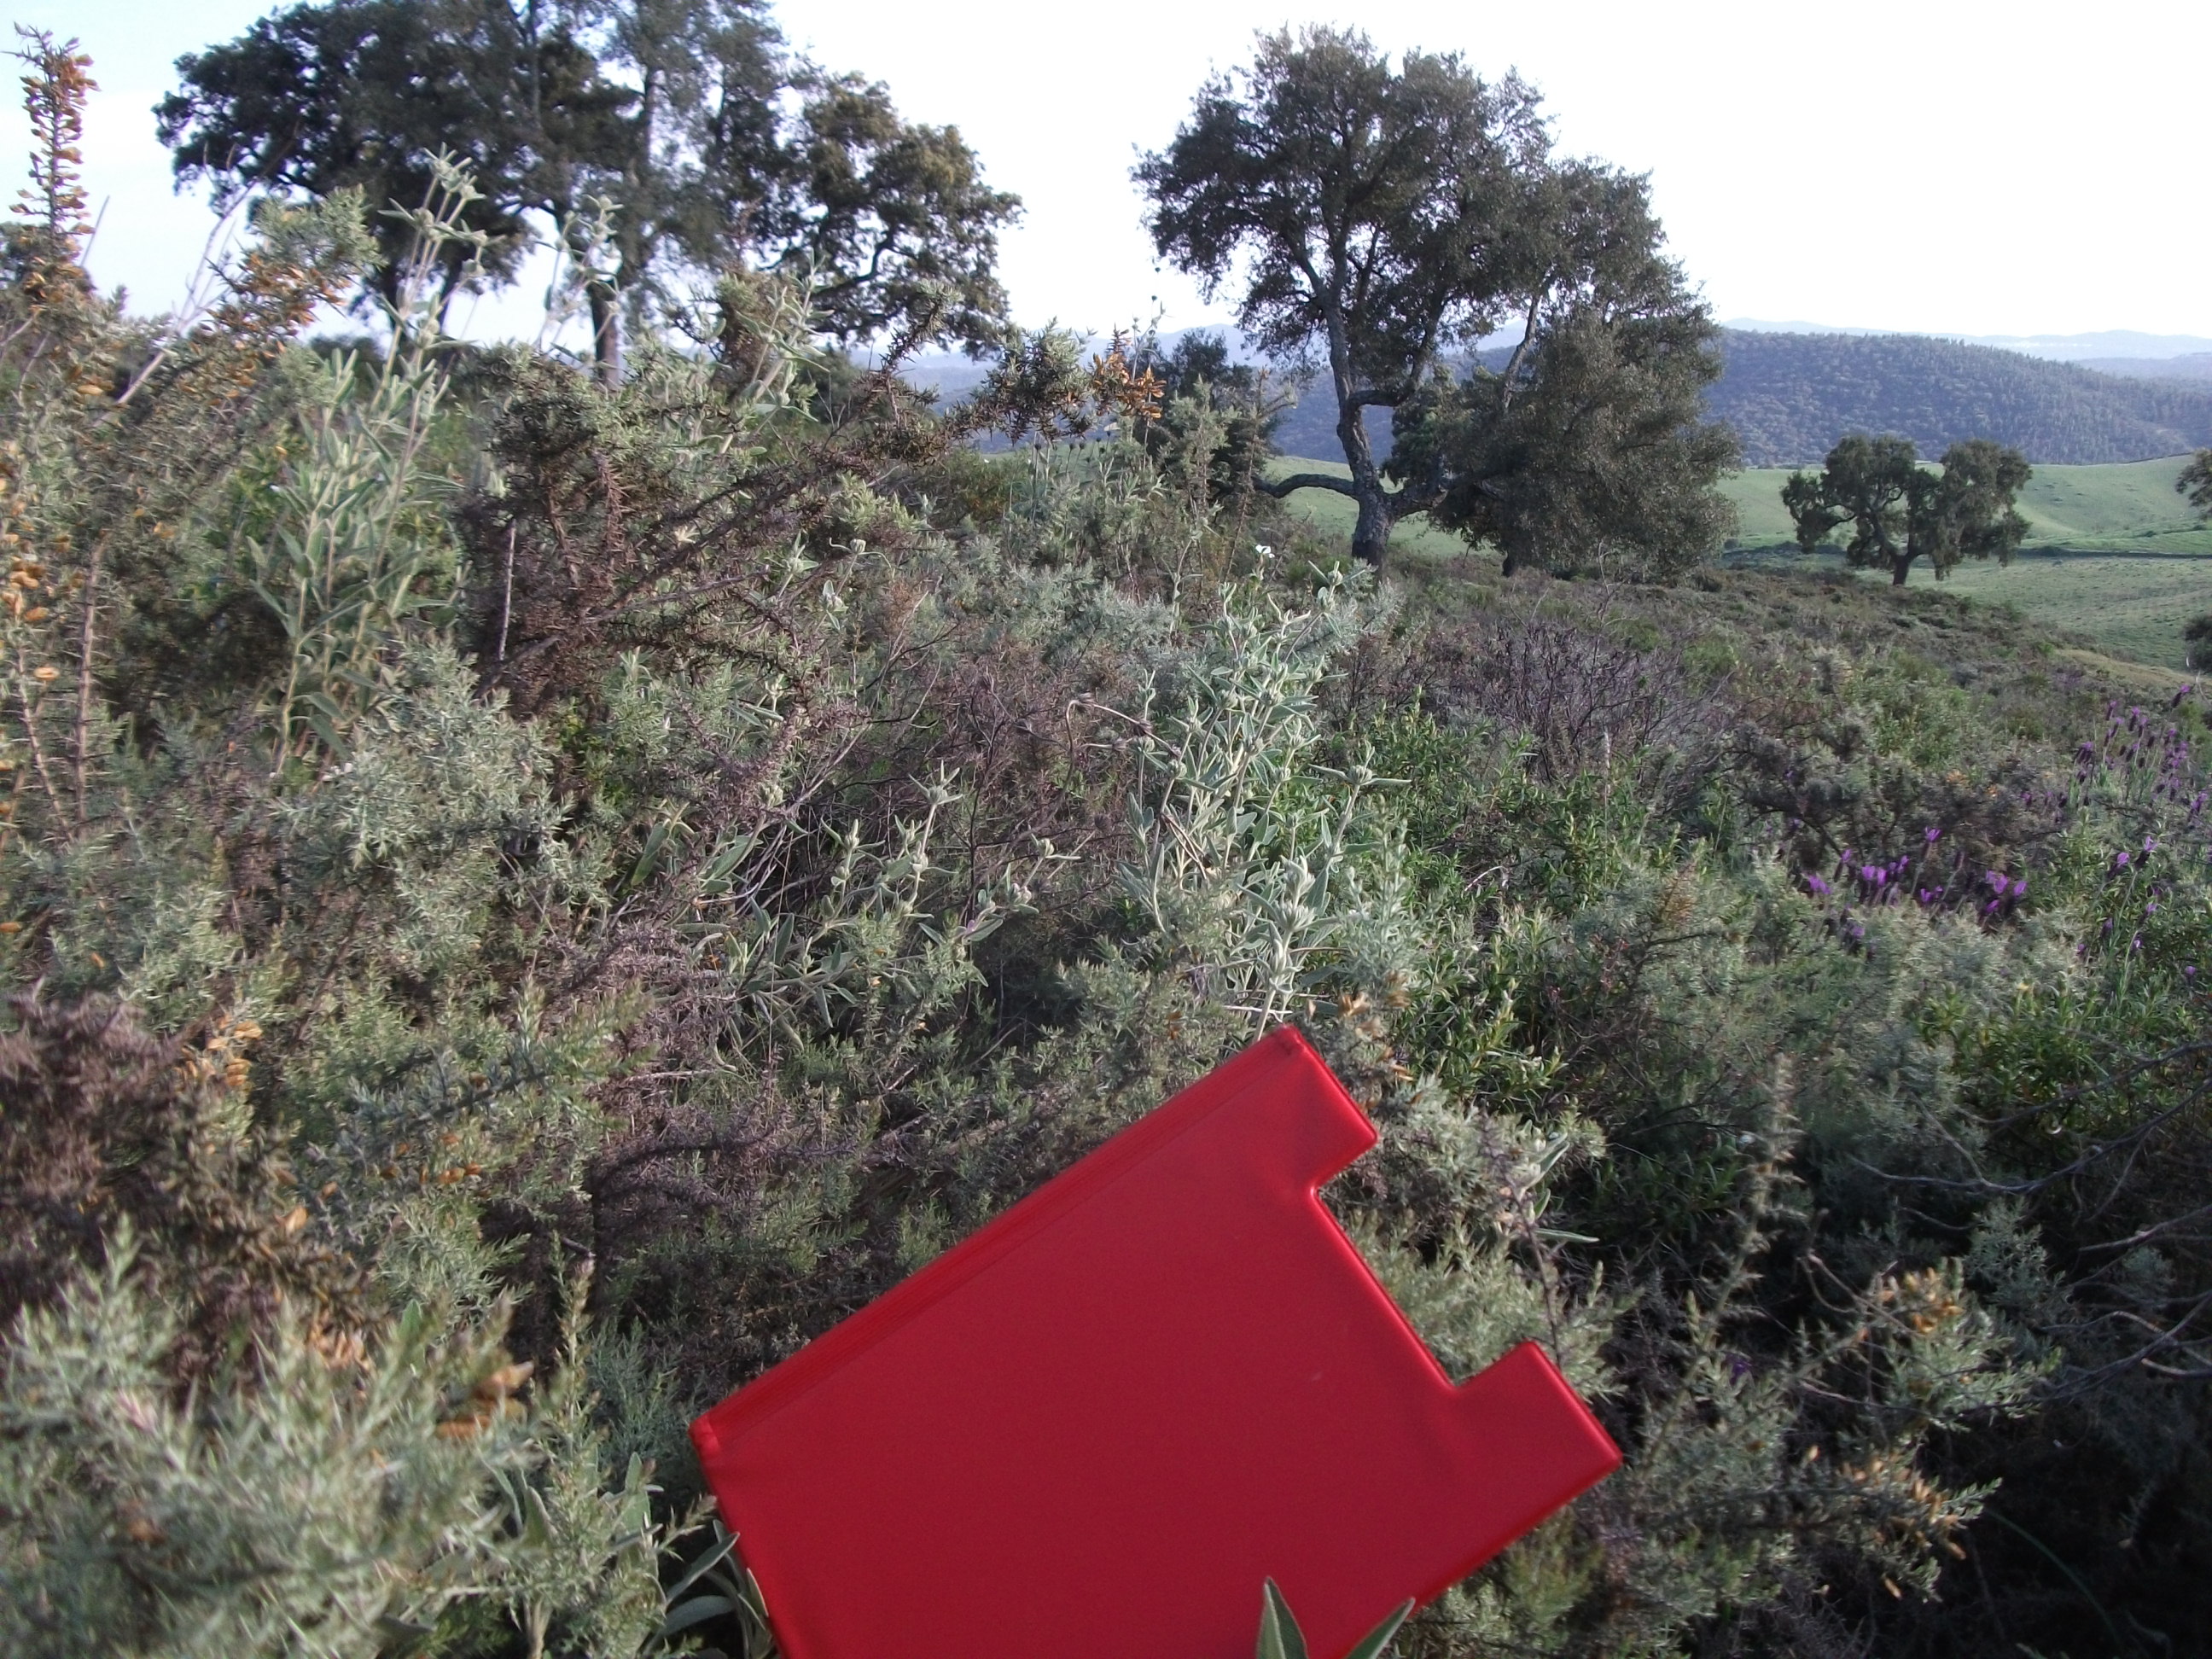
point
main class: Woodland
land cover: Broadleaved woodland
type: broadleaved evergreen forest
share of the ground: 10 - 25 %
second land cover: Shrubland without tree cover
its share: > 75 %
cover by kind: shrubs 90 %, broadleaved forest trees 10 %
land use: Forestry
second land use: Agriculture (excluding fallow land and kitchen gardens)
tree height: > 5 m
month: April
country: ES
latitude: 37.8756
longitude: -6.5386
